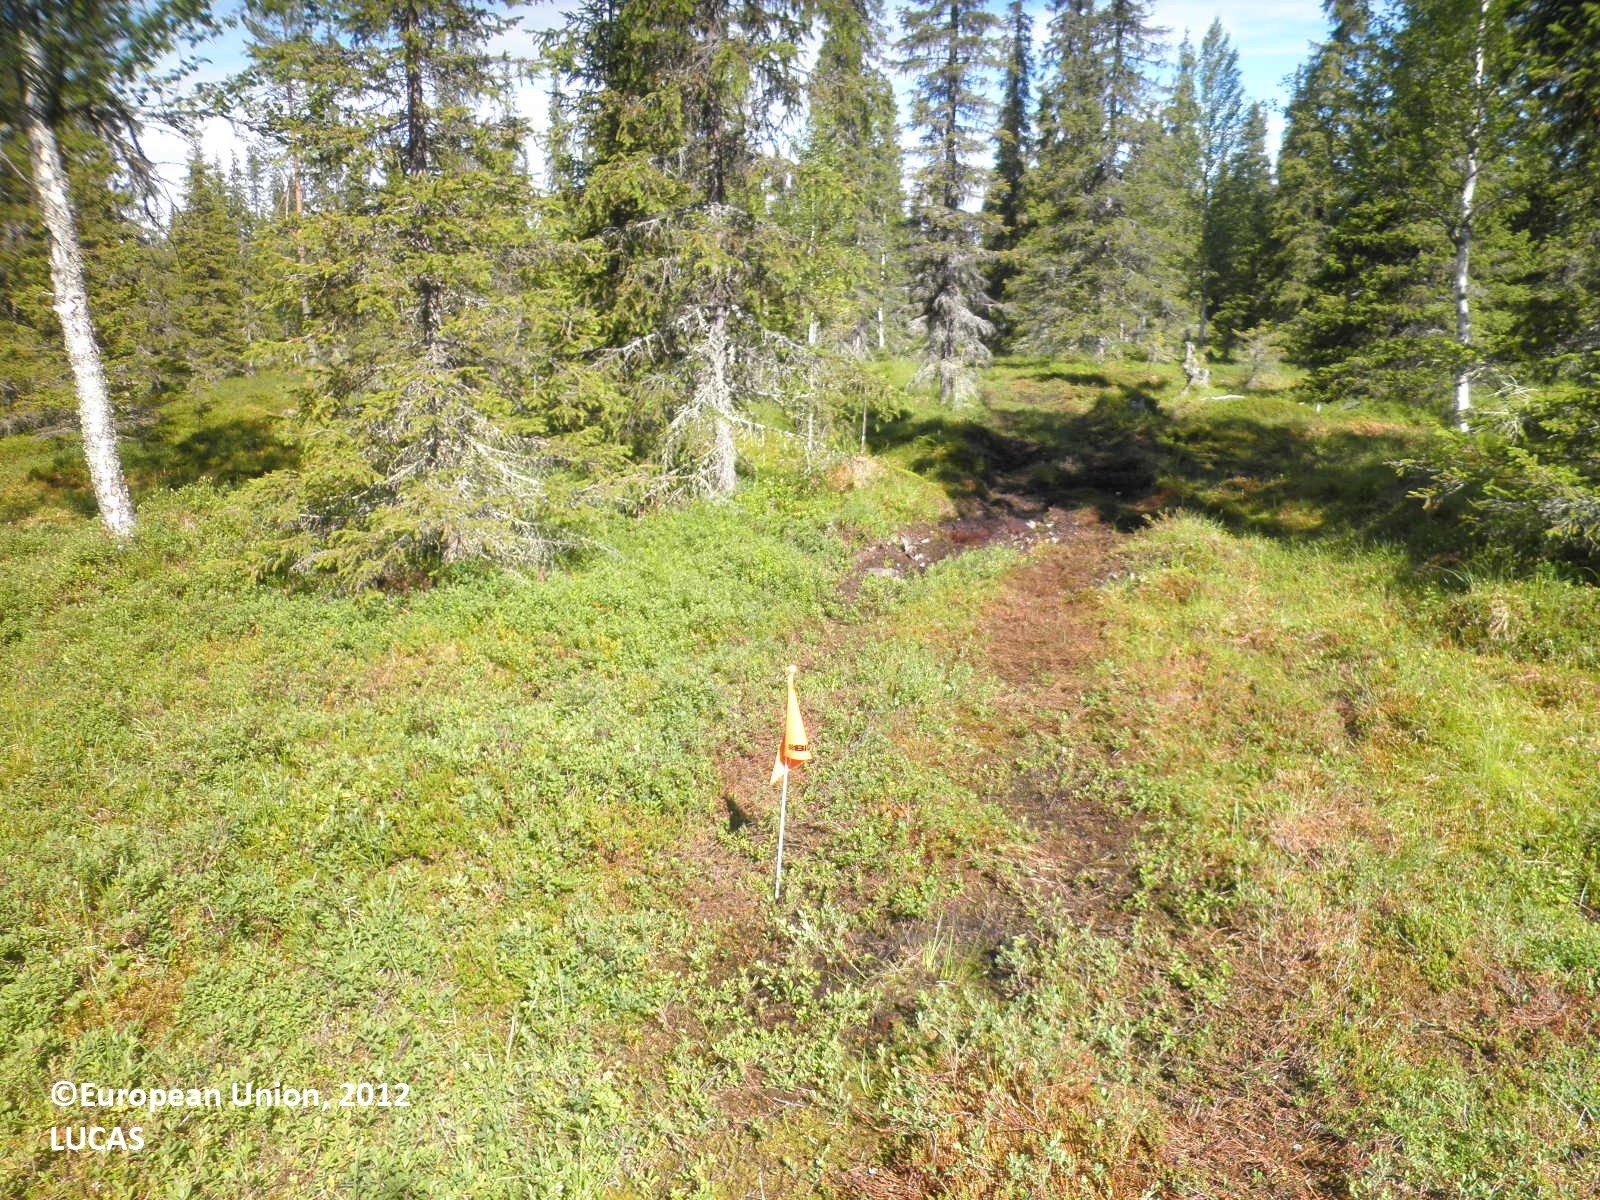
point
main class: Woodland
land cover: Spruce dominated mixed woodland
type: boreal forest
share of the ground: 25 - 50 %
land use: Forestry
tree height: > 5 m
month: July
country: FI
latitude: 67.7126
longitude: 26.2471
